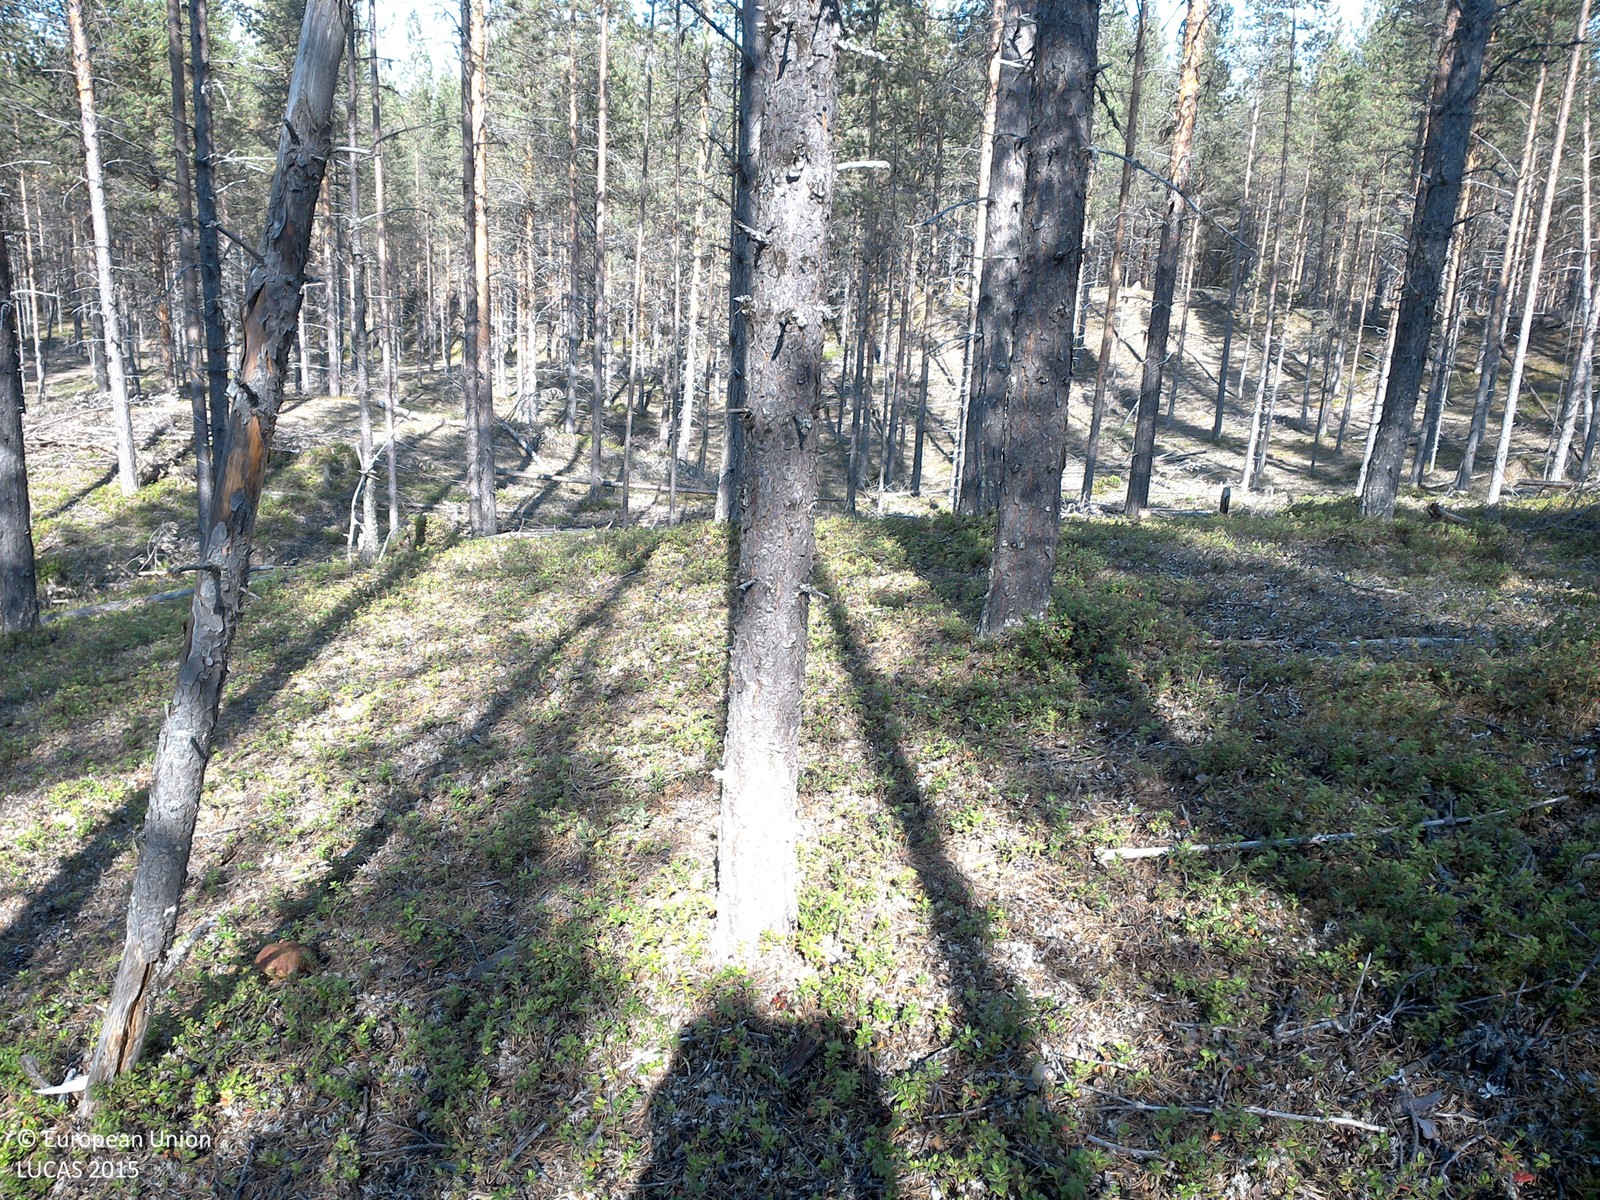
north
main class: Woodland
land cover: Pine dominated coniferous woodland
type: boreal forest
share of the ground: 25 - 50 %
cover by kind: lichens and mosses 45 %, coniferous forest trees 30 %, shrubs 25 %
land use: Forestry
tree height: > 5 m
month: August
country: SE
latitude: 67.3765
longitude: 22.1867
